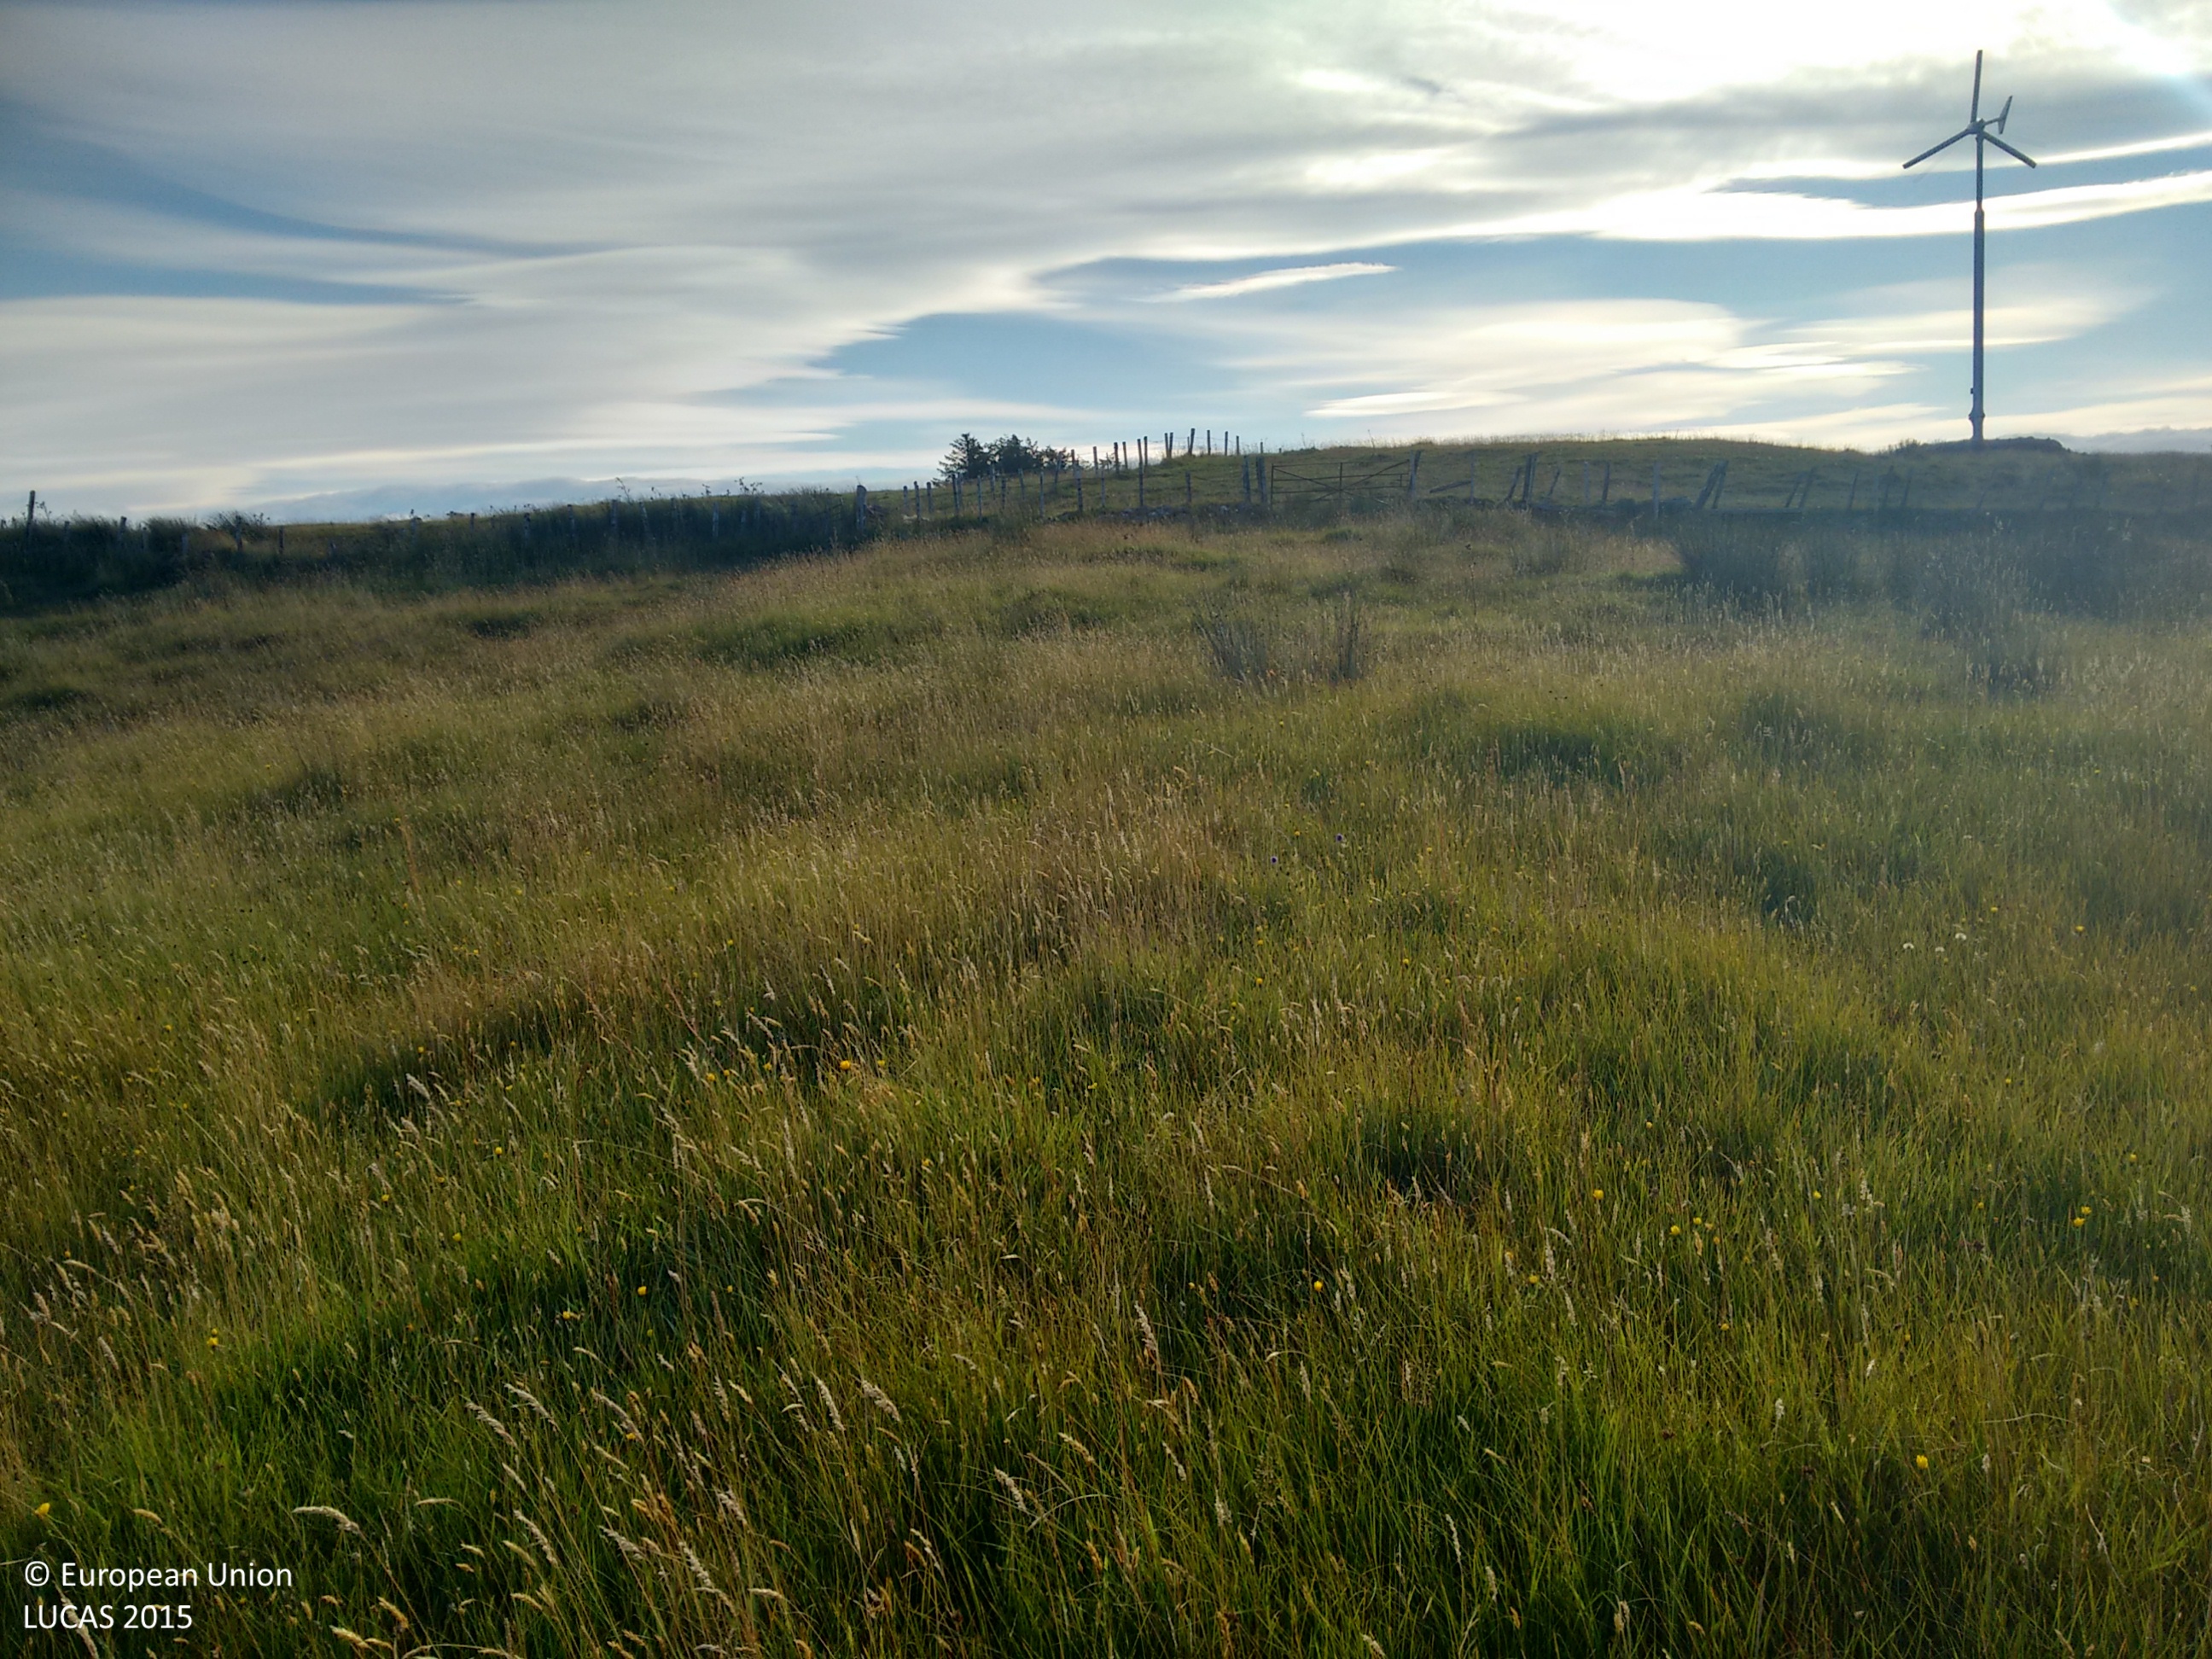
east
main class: Grassland
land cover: Grassland without tree/shrub cover
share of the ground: > 75 %
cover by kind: herbaceous plants 100 %
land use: Agriculture (excluding fallow land and kitchen gardens)
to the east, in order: Grassland without tree/shrub cover; Dry stone walls; Fences; Grassland without tree/shrub cover; Fences; Grassland without tree/shrub cover; Fences; Lines of trees; Dry stone walls; Fences; Tracks; Fences; Grassland without tree/shrub cover
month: September
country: GB
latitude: 58.0428
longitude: -4.3996
